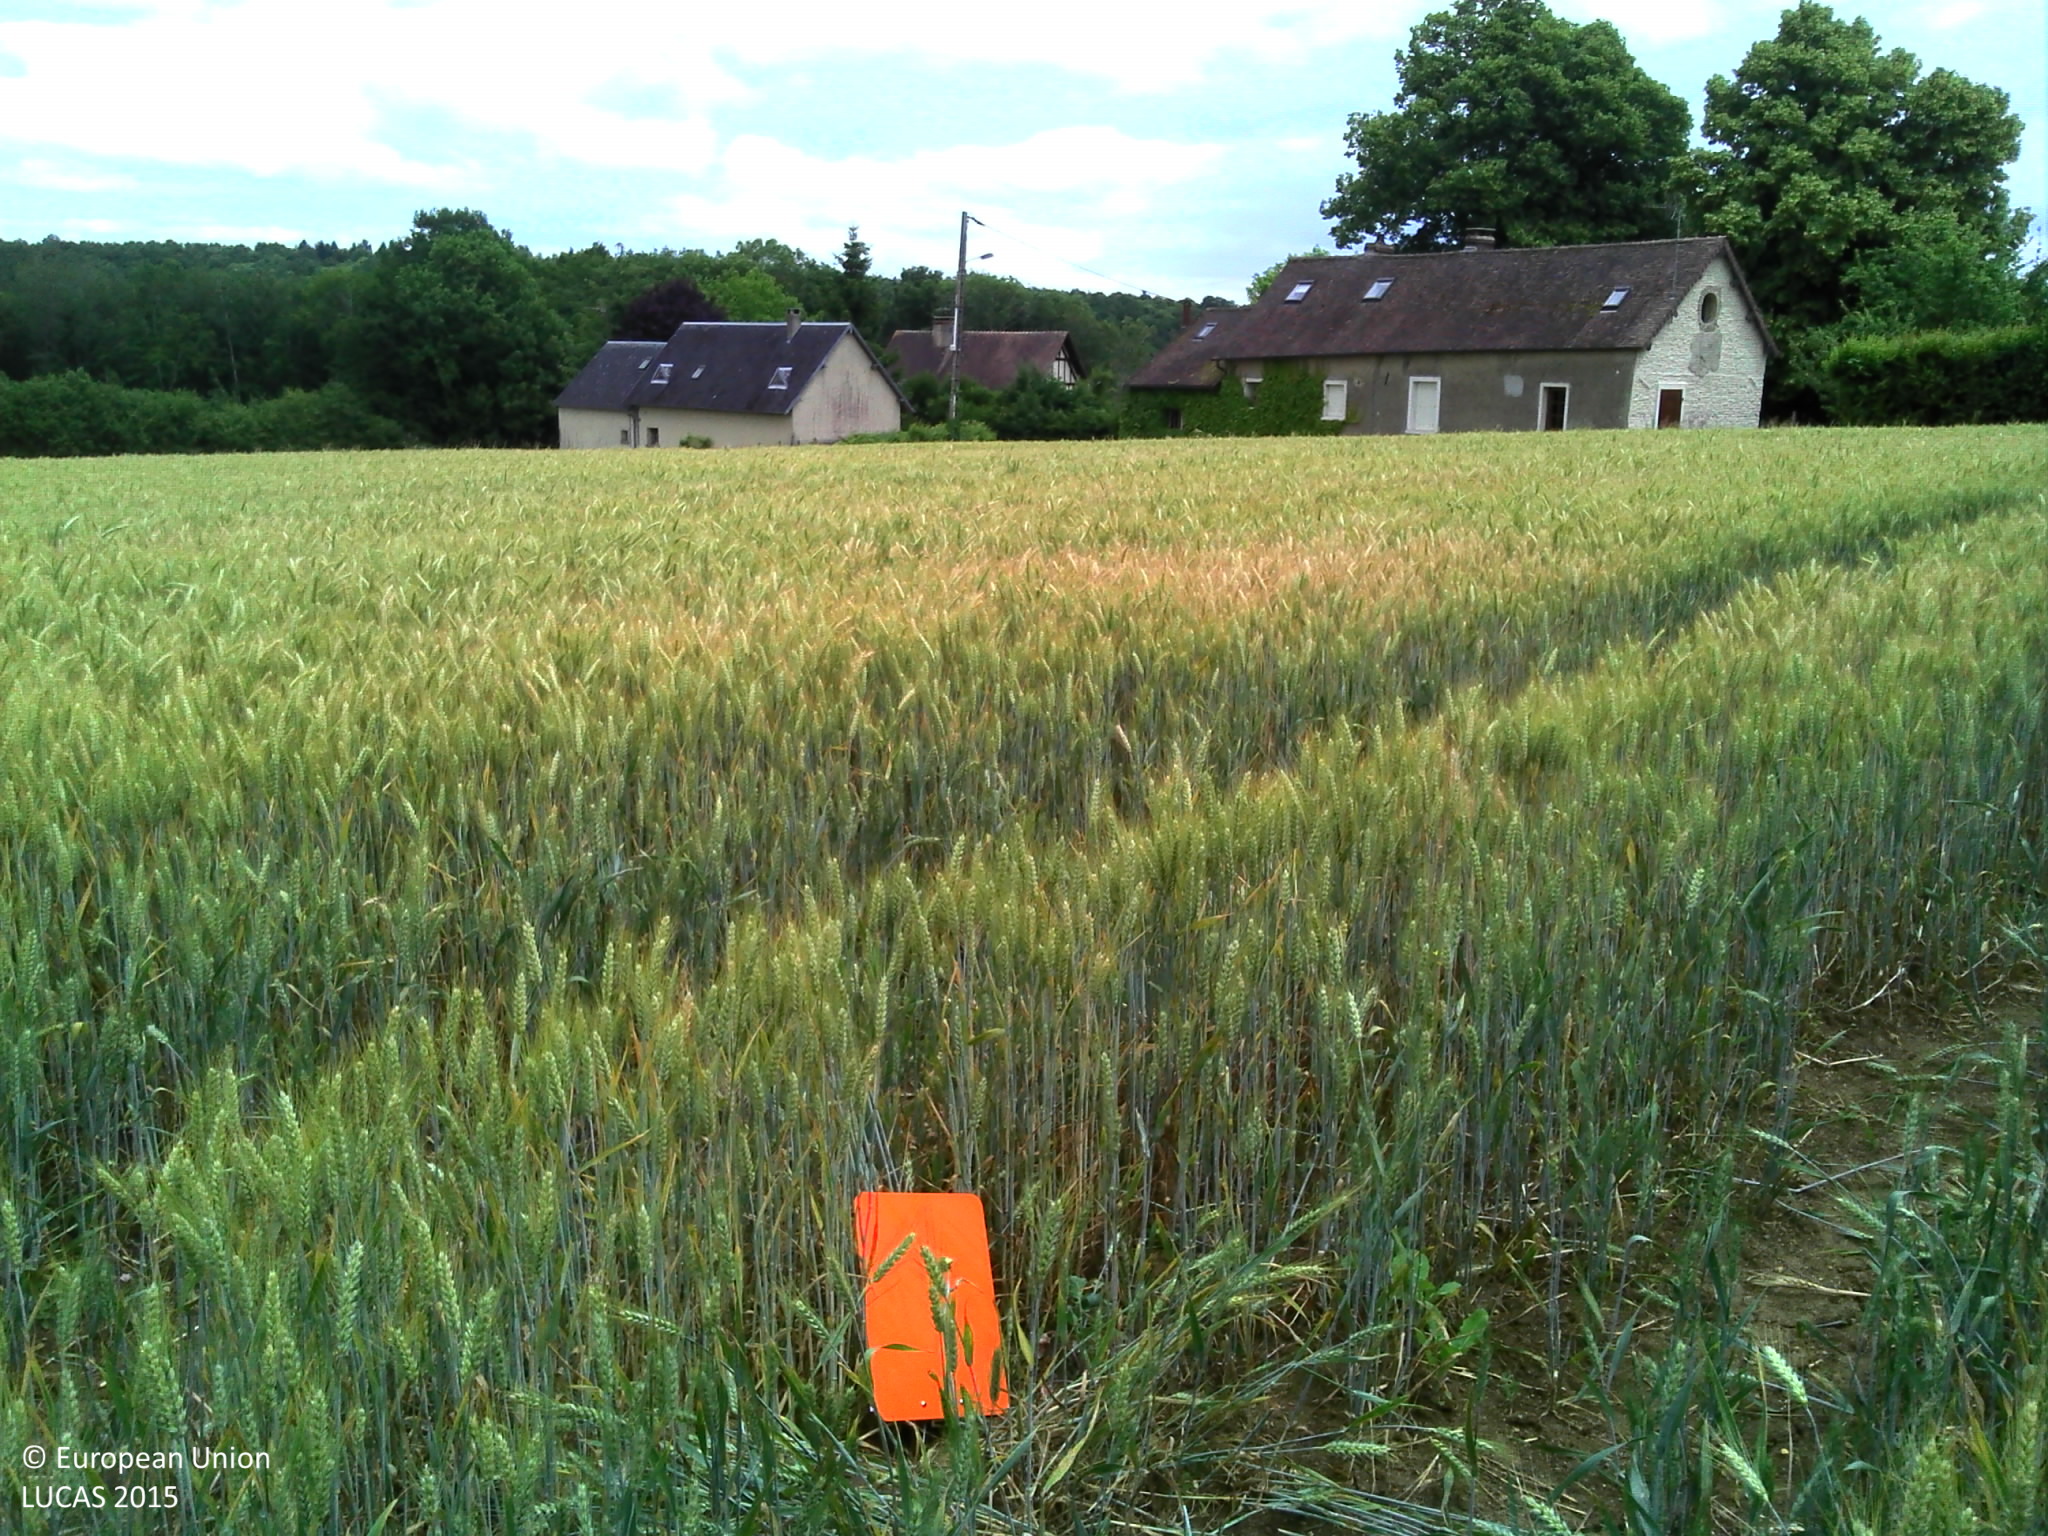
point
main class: Cropland
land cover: Common wheat
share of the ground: > 75 %
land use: Agriculture (excluding fallow land and kitchen gardens)
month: June
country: FR
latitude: 49.0524
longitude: 1.2642
